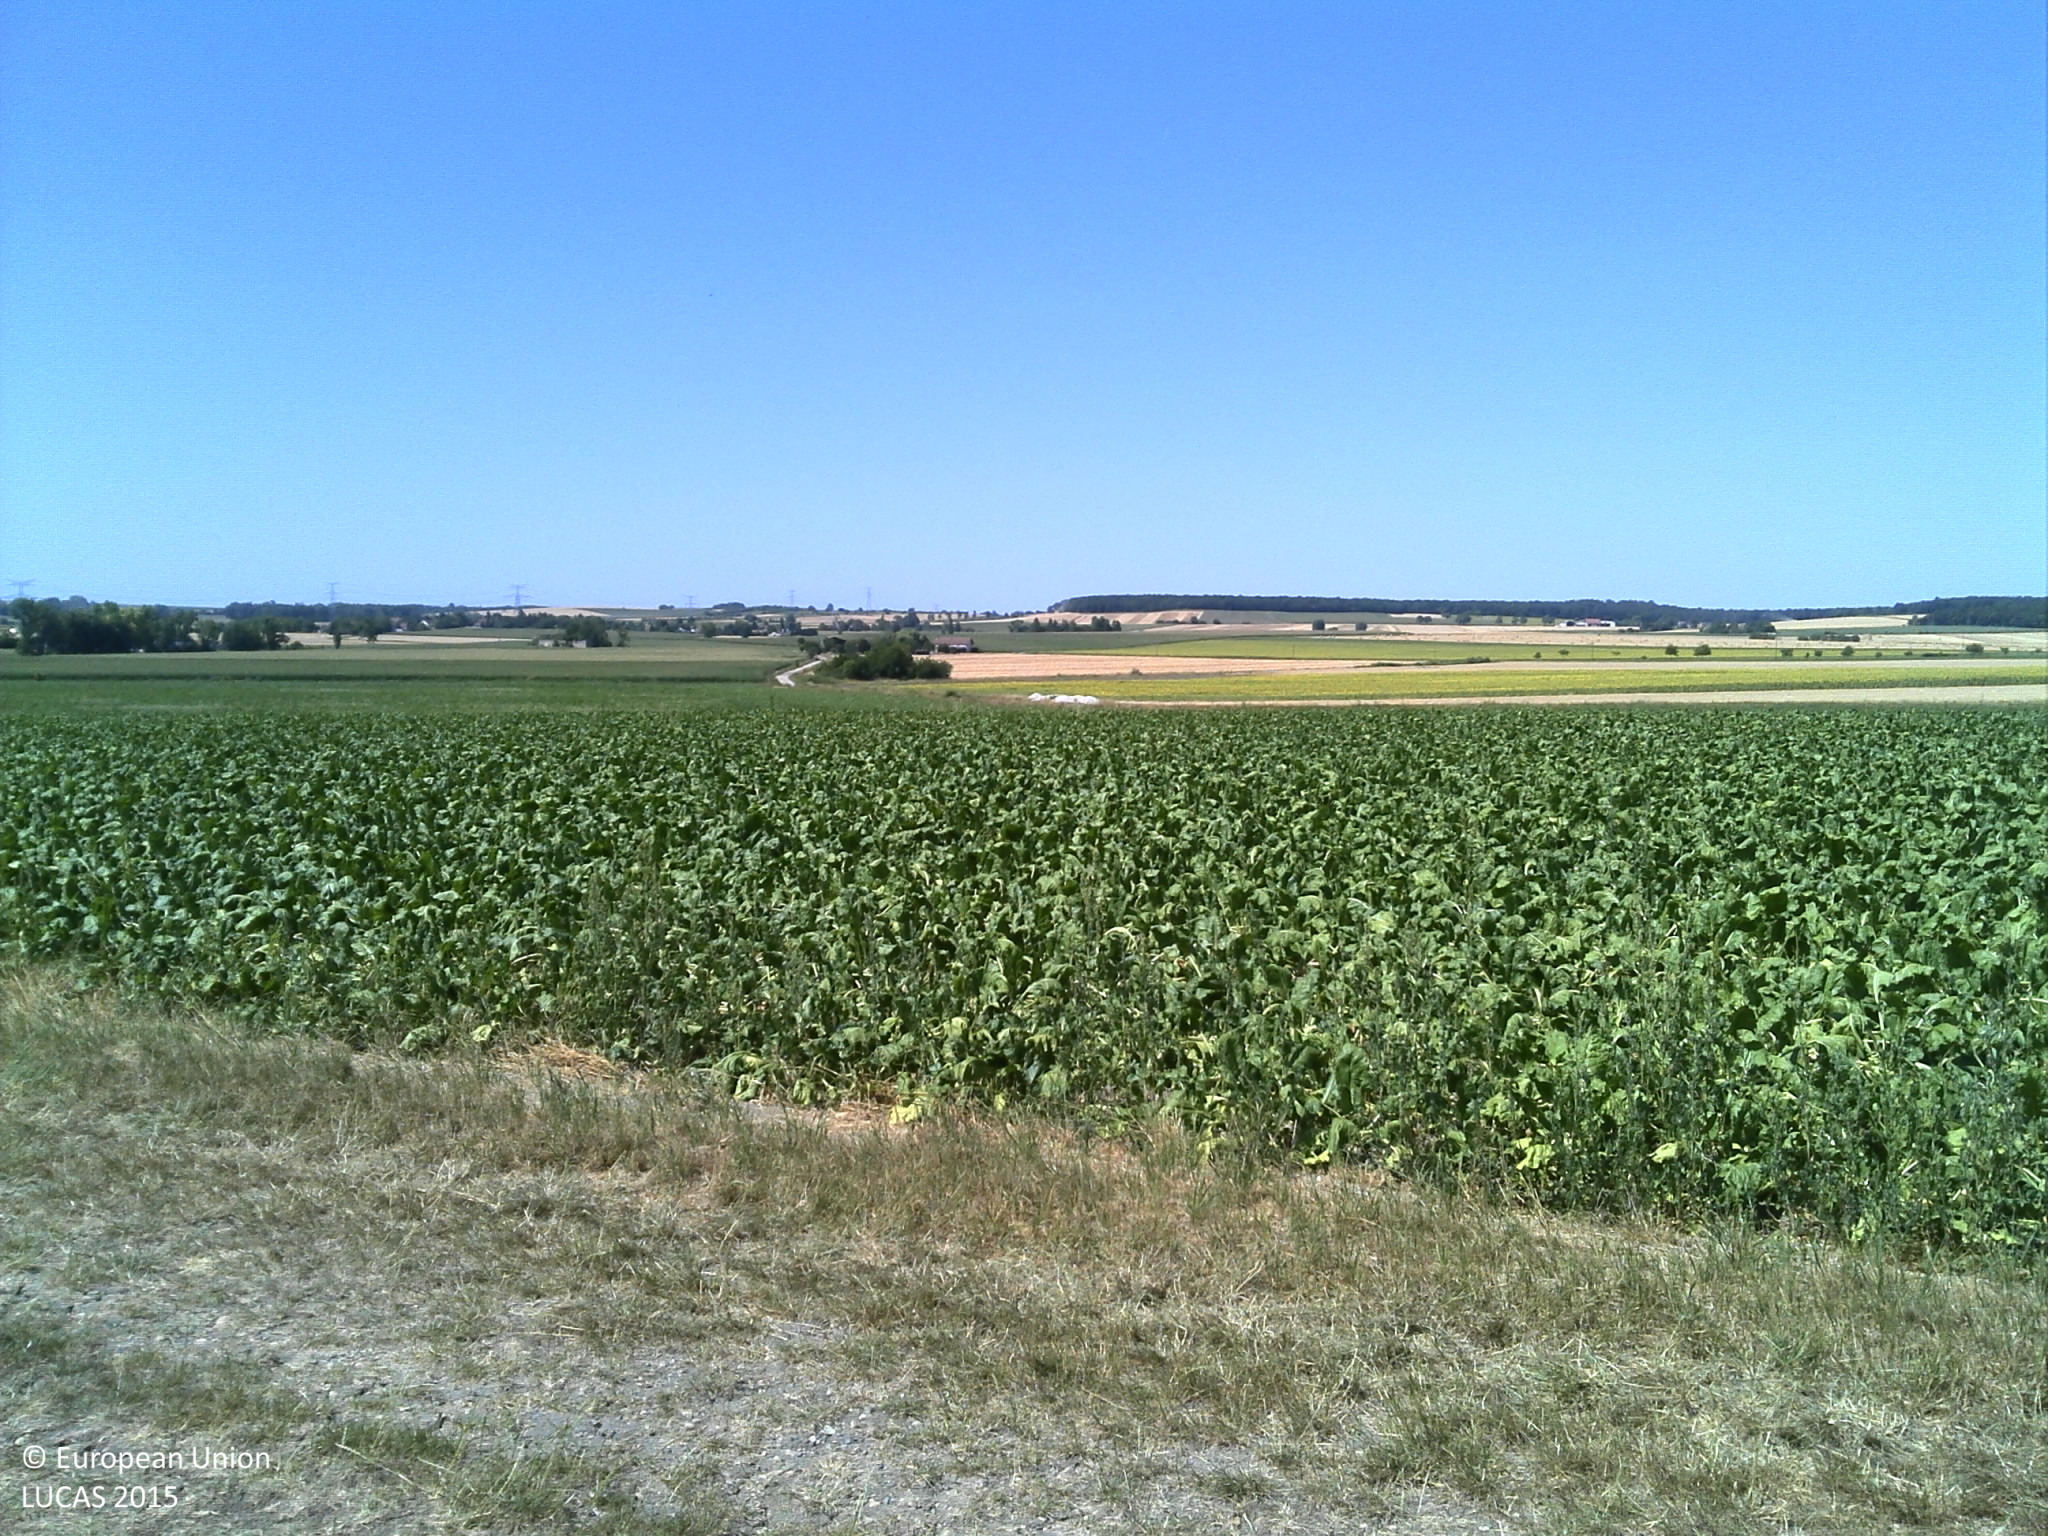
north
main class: Cropland
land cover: Maize
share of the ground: > 75 %
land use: Agriculture (excluding fallow land and kitchen gardens)
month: October
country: FR
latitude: 46.0322
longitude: 3.2941
